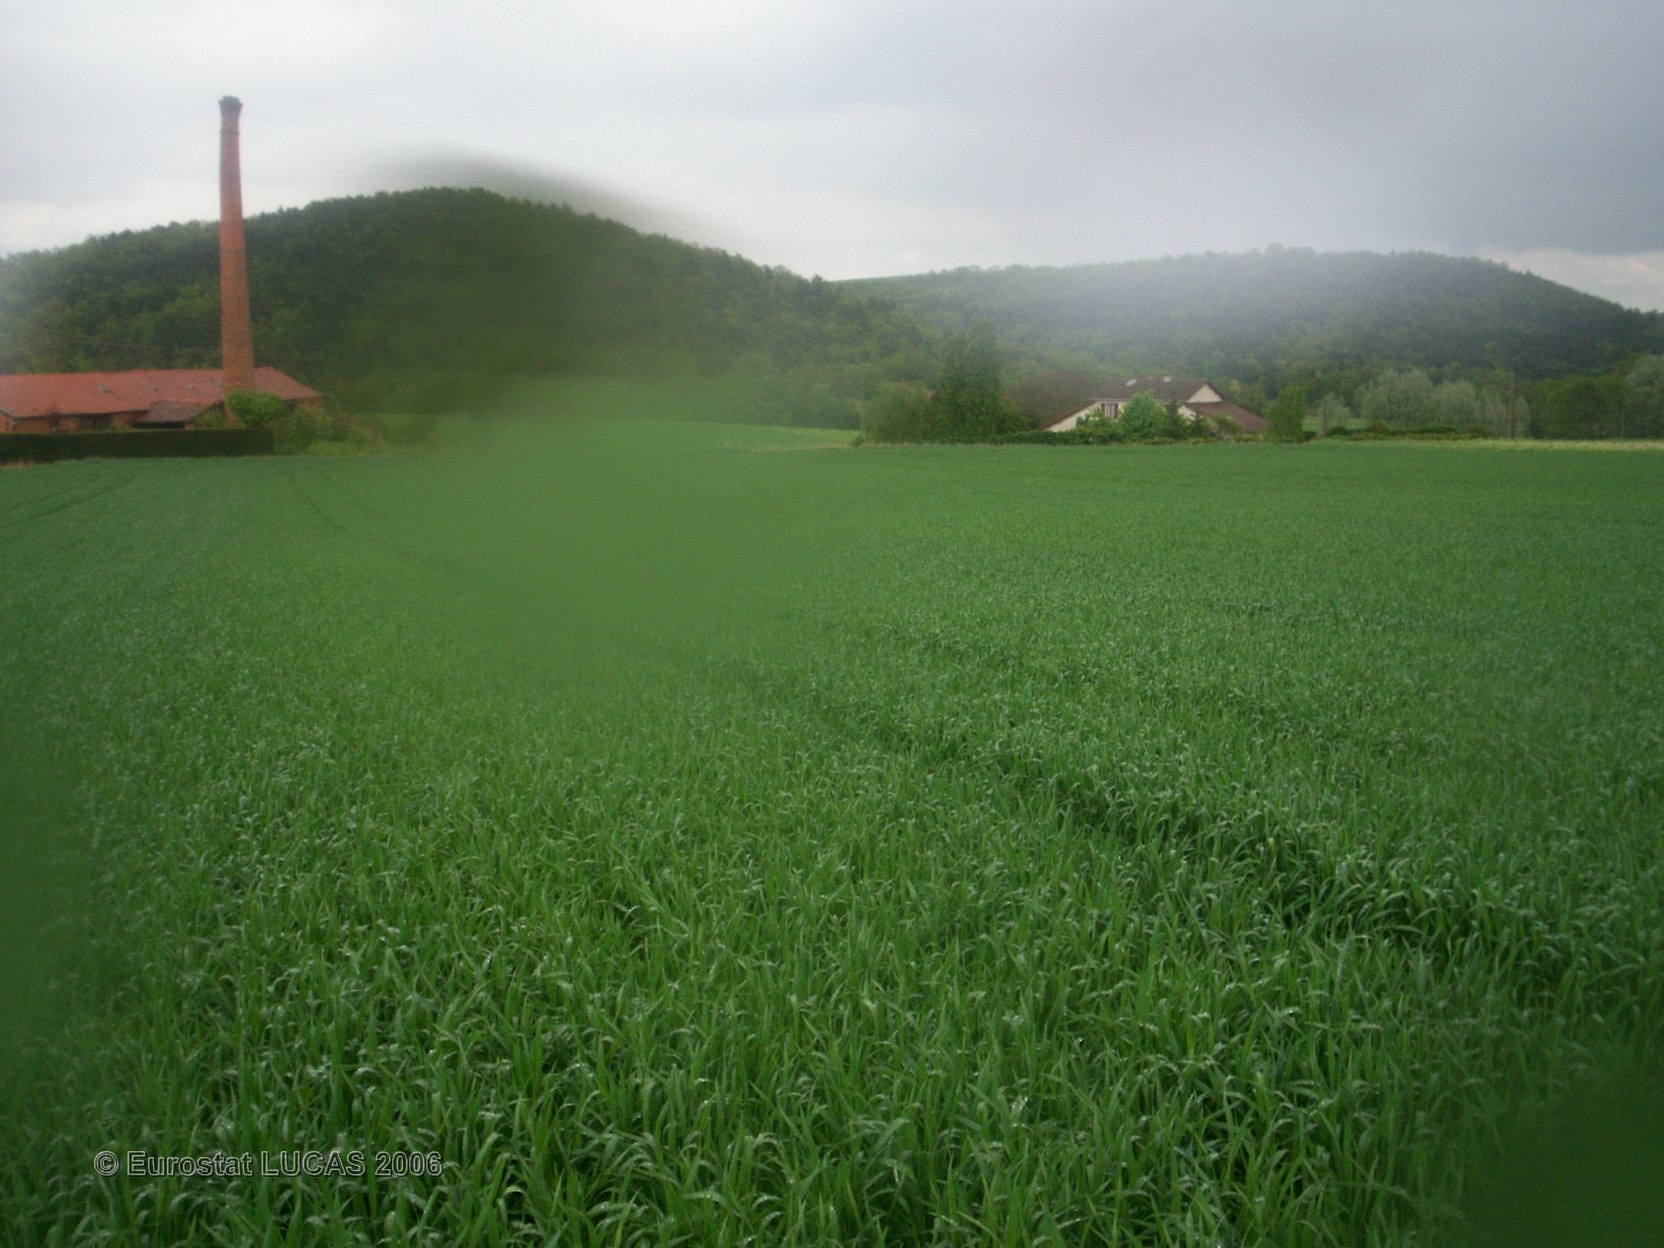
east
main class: Cropland
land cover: Common wheat
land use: Agriculture (excluding fallow land and kitchen gardens)
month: May
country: FR
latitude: 45.6050
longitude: 3.1152
